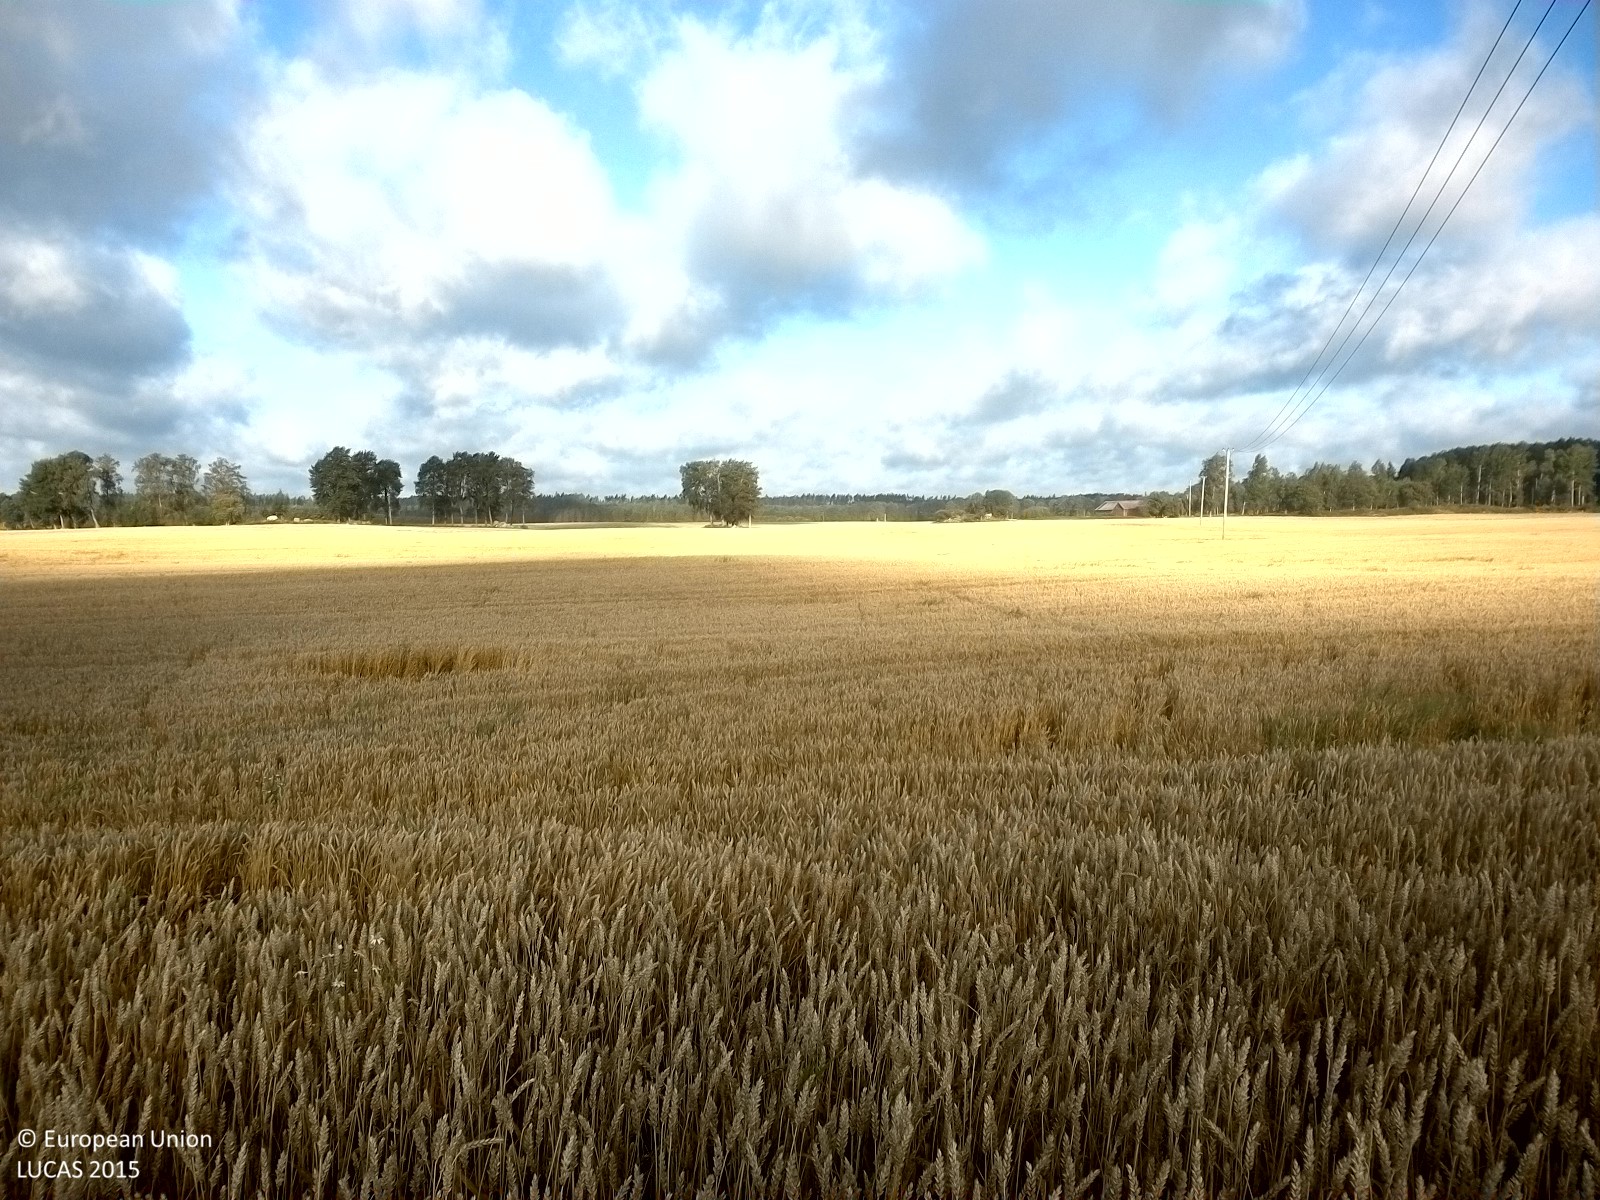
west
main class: Cropland
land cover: Common wheat
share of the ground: > 75 %
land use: Agriculture (excluding fallow land and kitchen gardens)
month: August
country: SE
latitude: 58.9201
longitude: 15.4635
